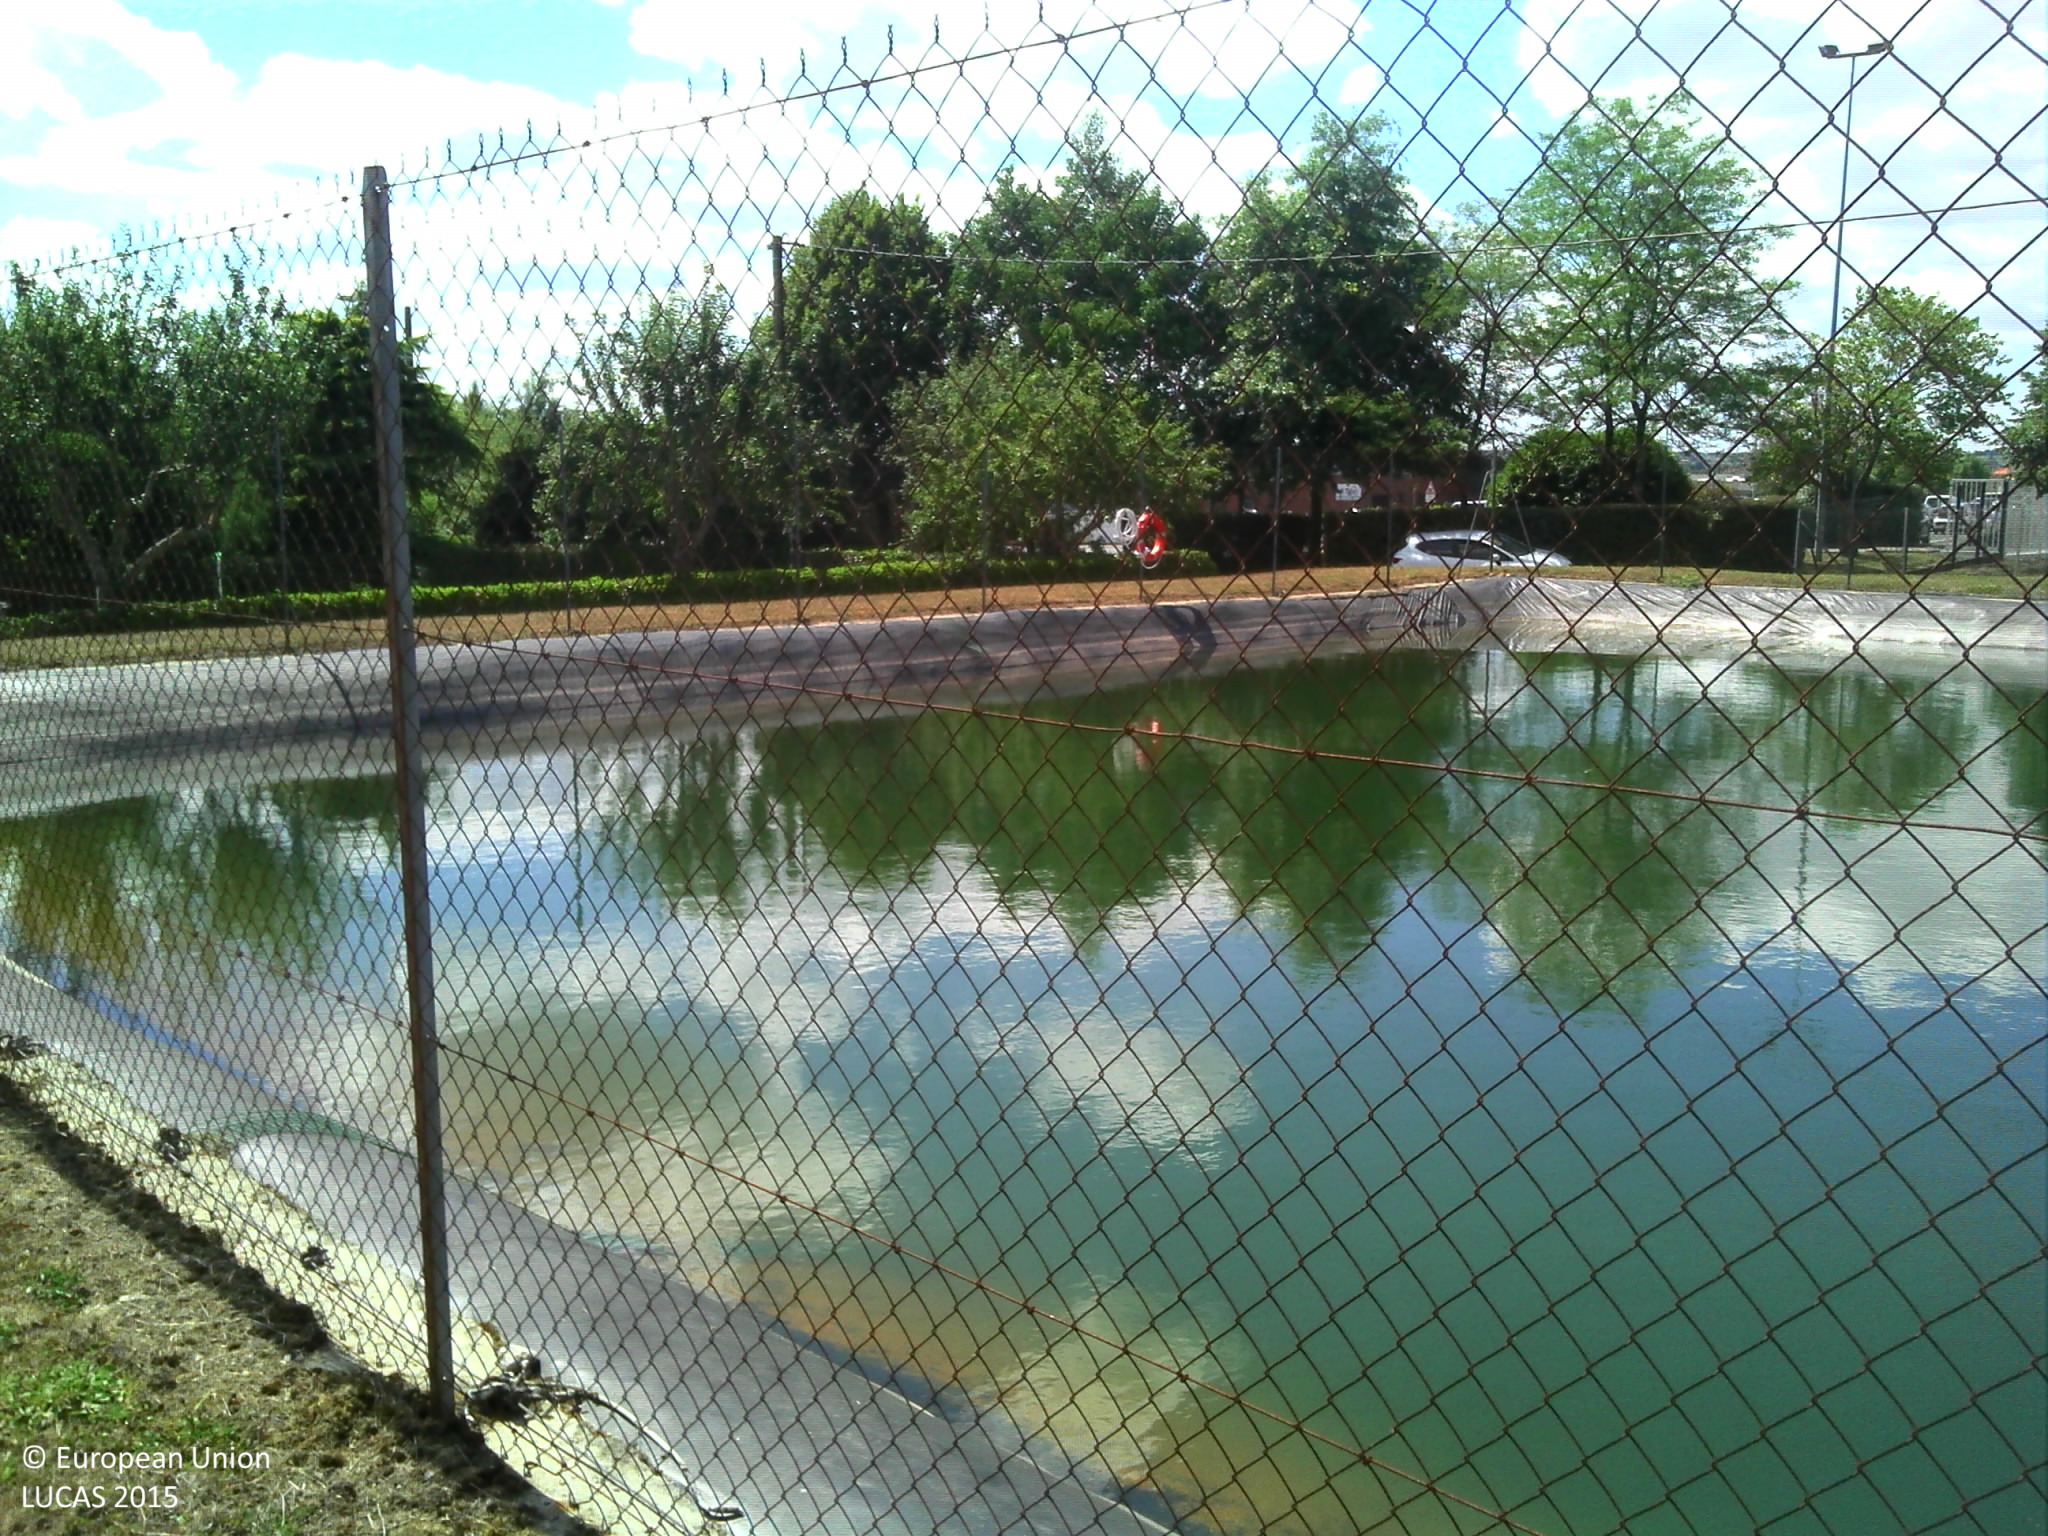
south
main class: Grassland
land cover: Grassland without tree/shrub cover
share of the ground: > 75 %
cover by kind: herbaceous plants 100 %
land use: Water supply and treatment
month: July
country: FR
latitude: 46.9879
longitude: -0.9333
